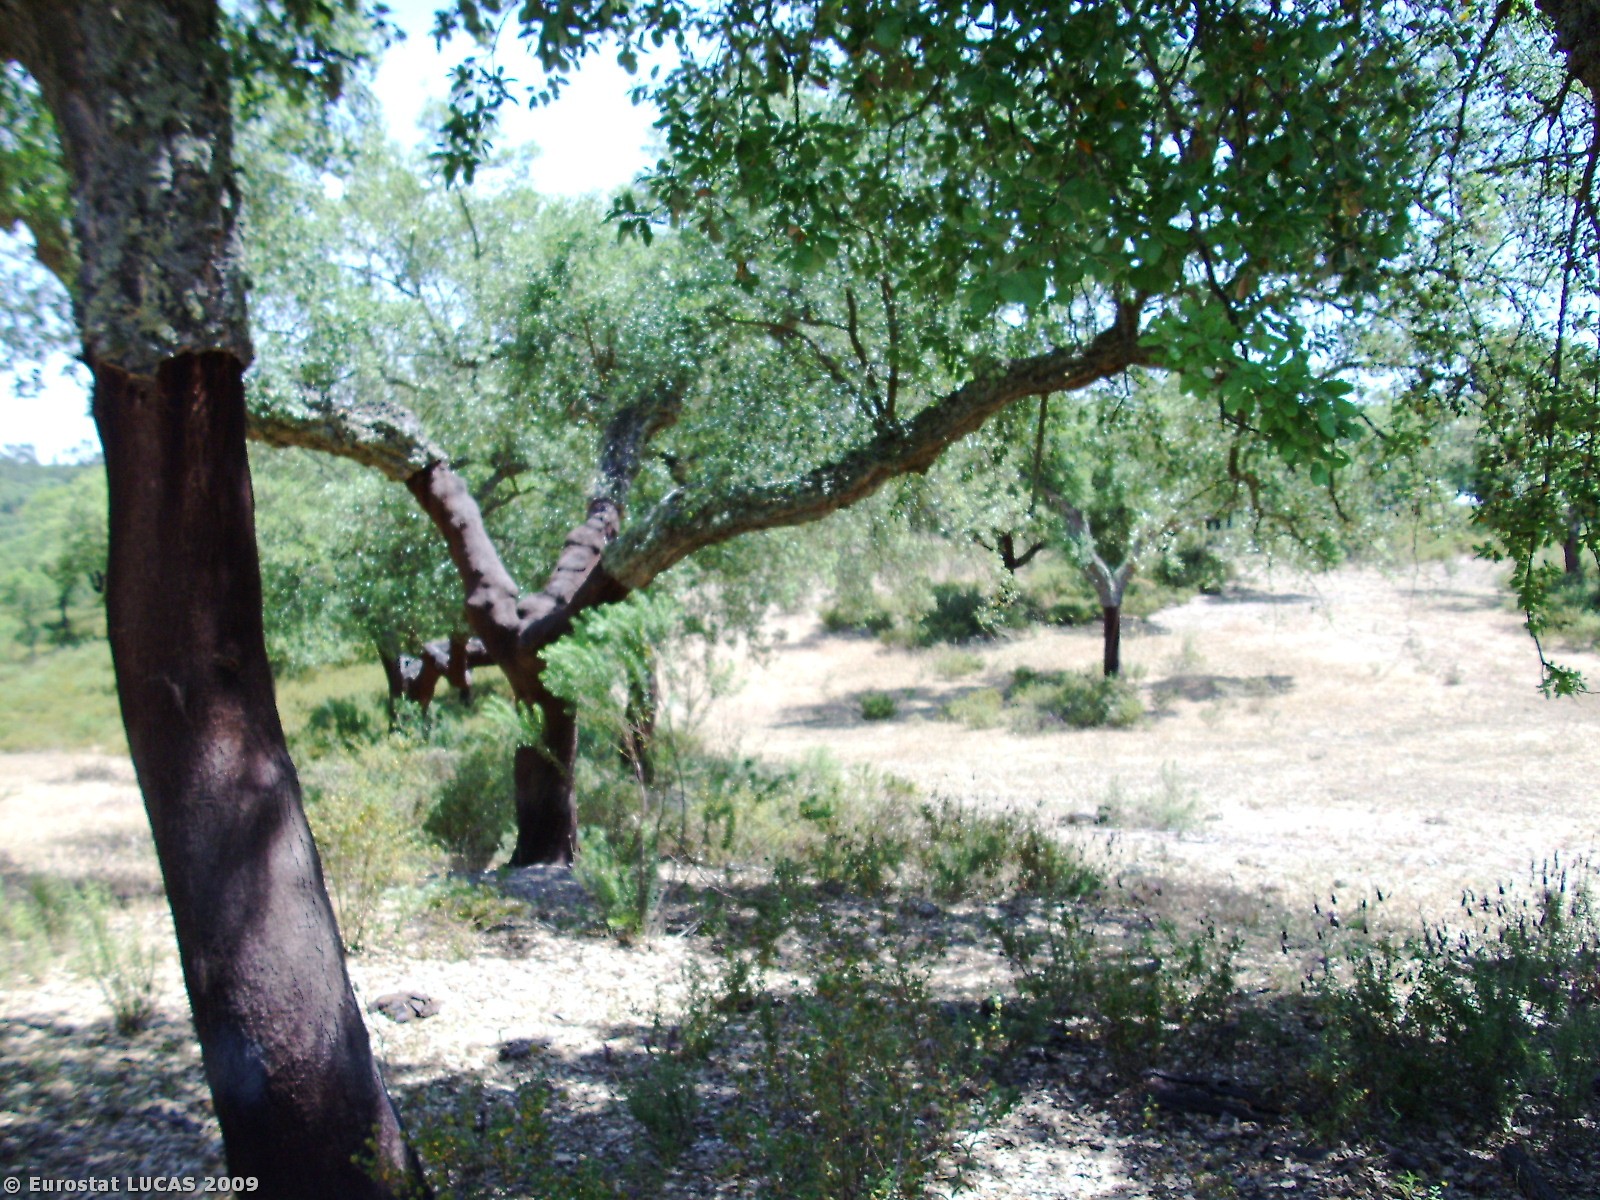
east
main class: Woodland
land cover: Broadleaved woodland
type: broadleaved evergreen forest
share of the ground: 50 - 75 %
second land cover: Spontaneously vegetated surfaces
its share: 25 - 50 %
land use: Forestry
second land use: Fallow land
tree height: > 5 m
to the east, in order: Broadleaved woodland; Spontaneously vegetated surfaces; Broadleaved woodland
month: May
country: PT
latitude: 39.0063
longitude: -8.0306
